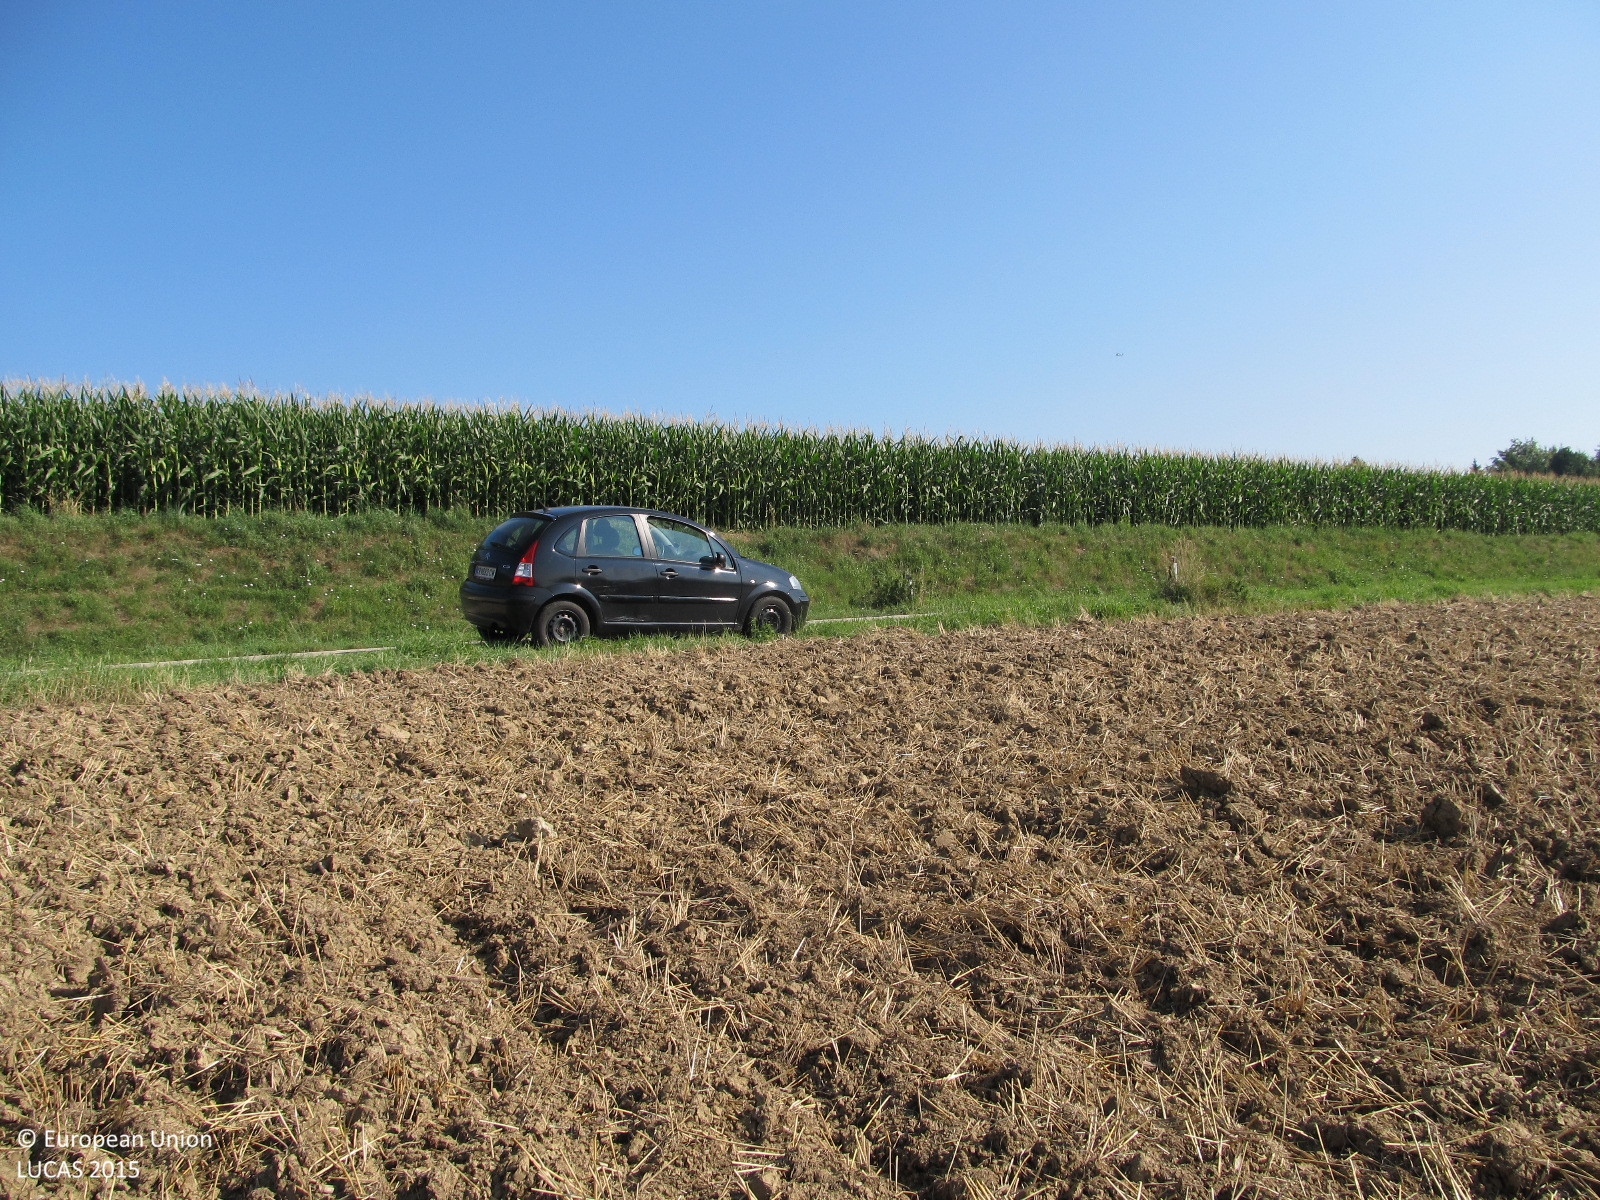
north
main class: Cropland
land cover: Common wheat
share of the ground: 10 - 25 %
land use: Agriculture (excluding fallow land and kitchen gardens)
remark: Harvested field
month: August
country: AT
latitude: 48.2136
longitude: 15.8306
